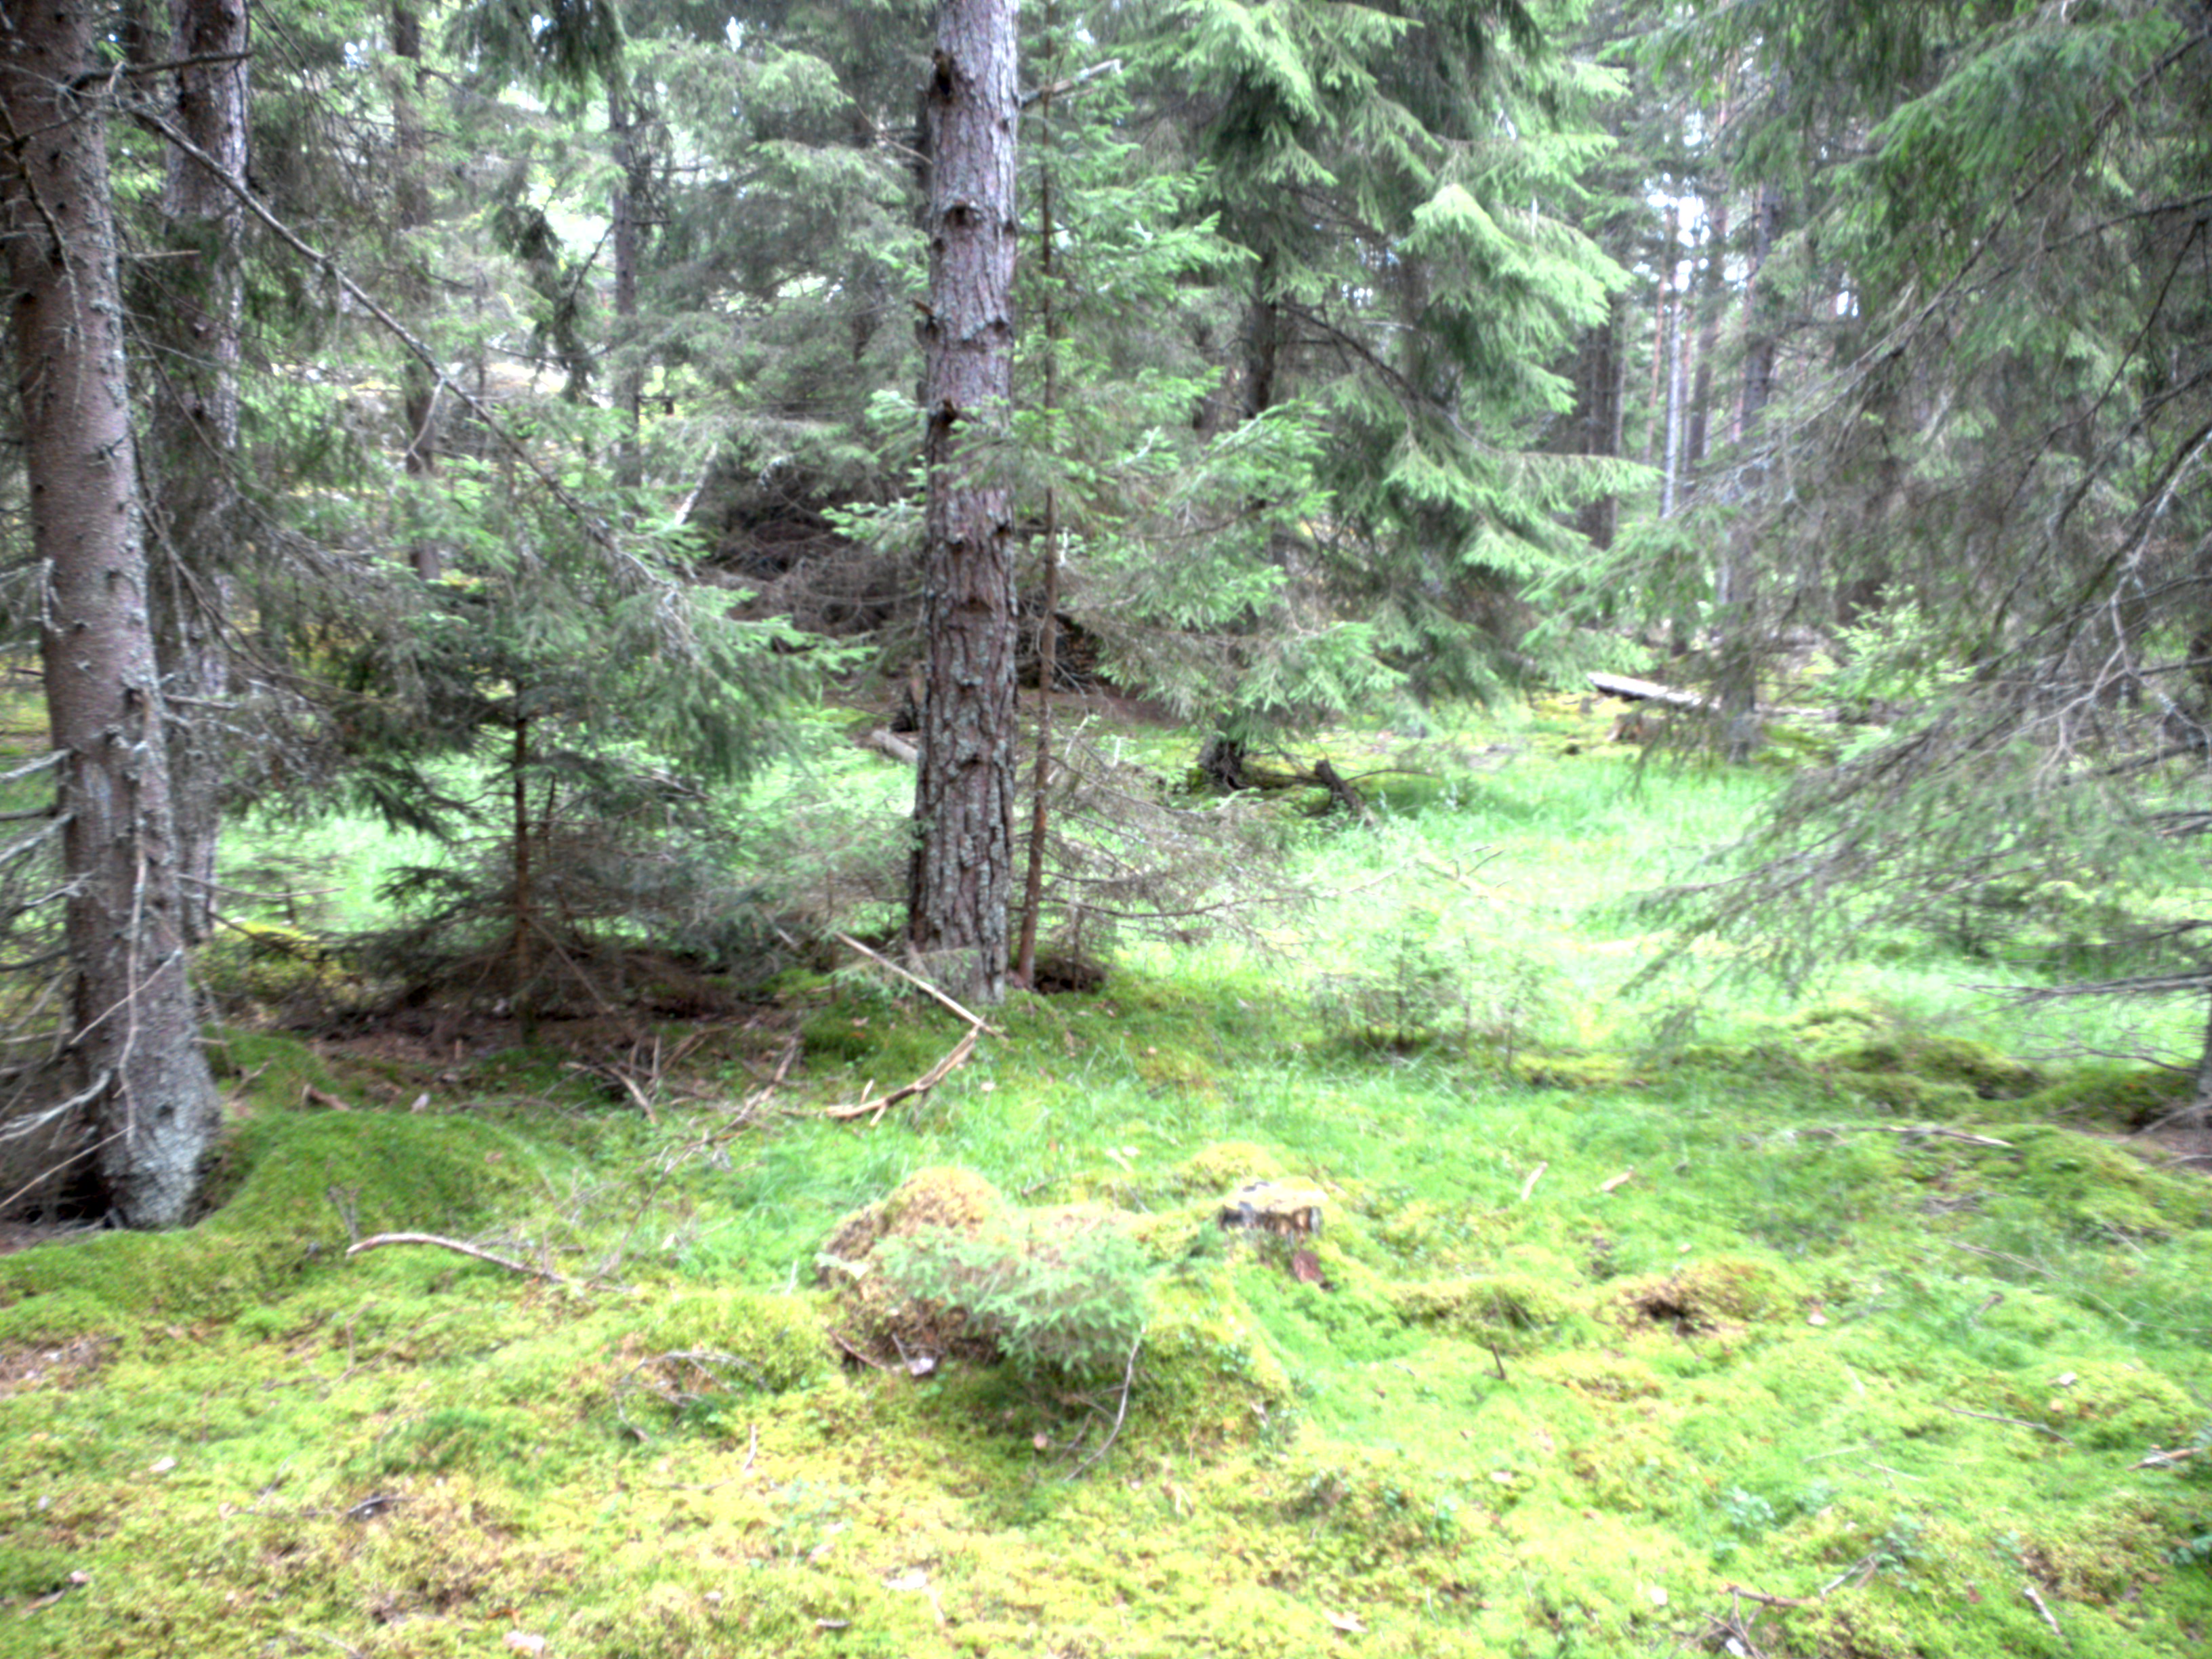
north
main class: Woodland
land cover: Spruce dominated coniferous woodland
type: boreal forest
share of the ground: 50 - 75 %
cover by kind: coniferous forest trees 65 %, lichens and mosses 35 %
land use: Forestry
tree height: > 5 m
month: July
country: SE
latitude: 59.1232
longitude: 18.2639
